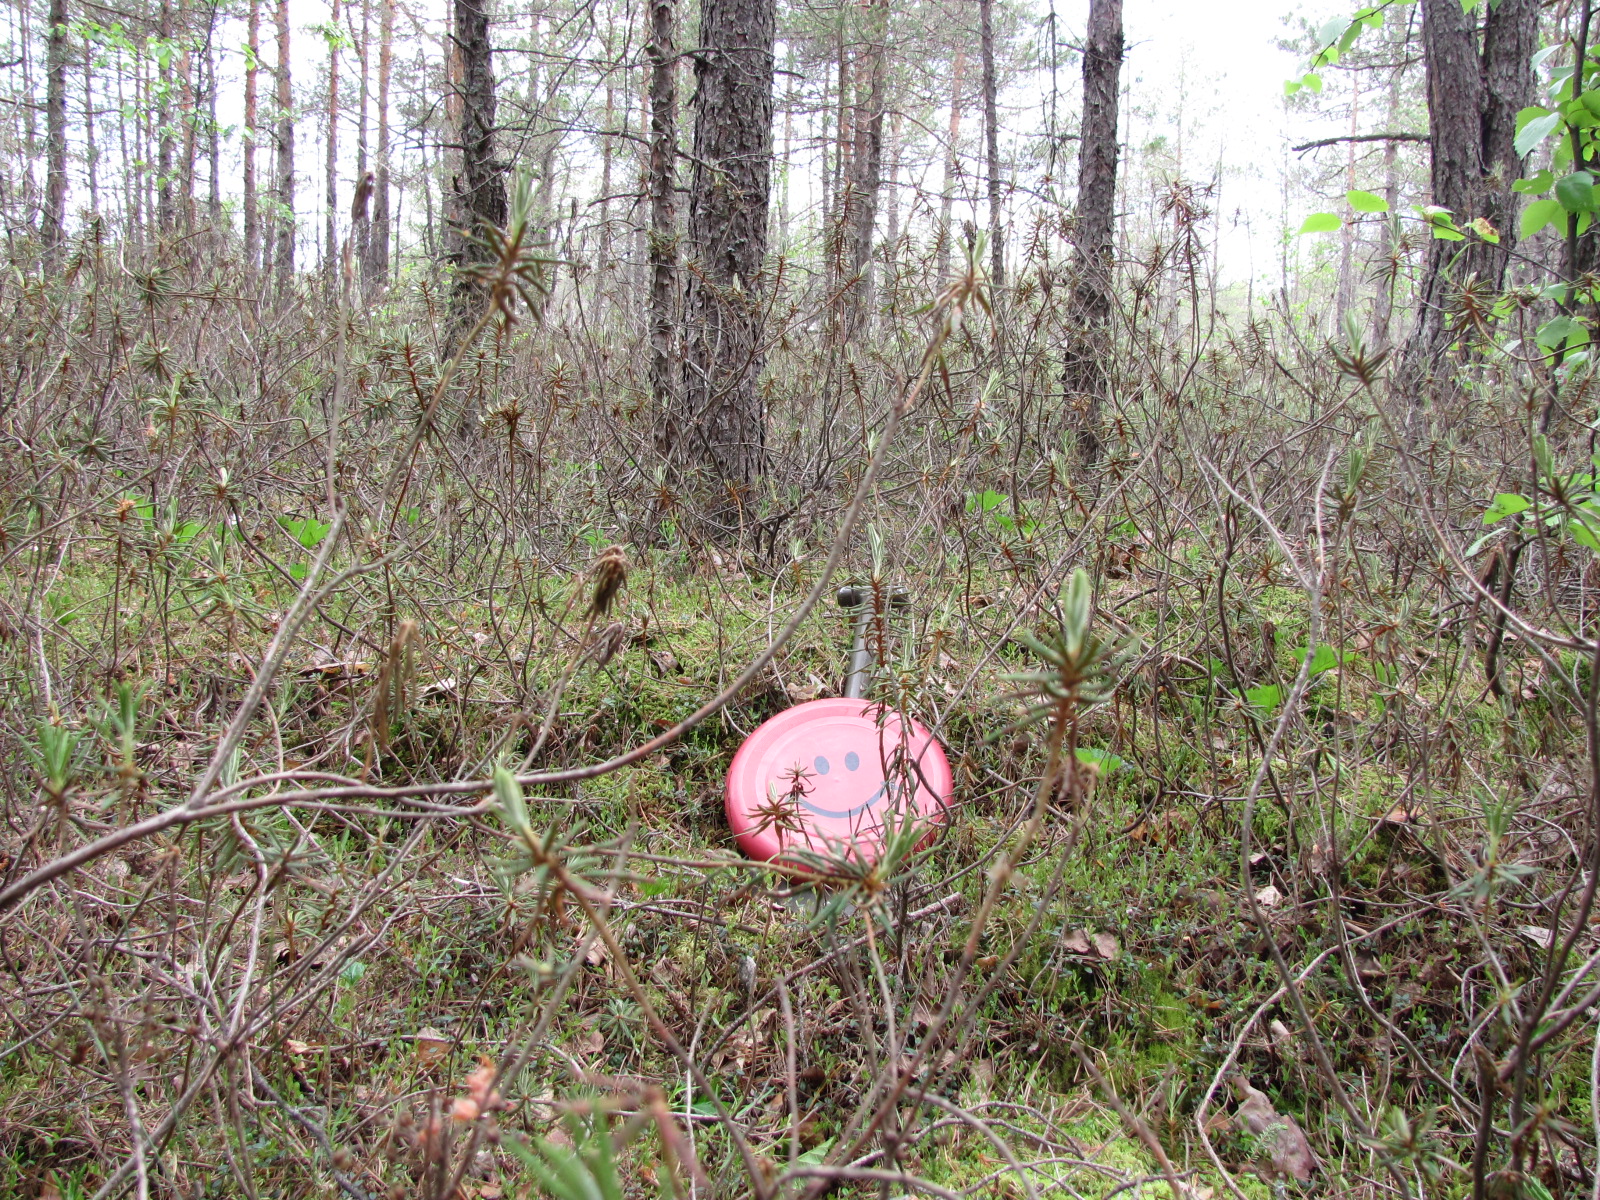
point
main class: Woodland
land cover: Pine dominated coniferous woodland
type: mire and swamp forests
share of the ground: > 75 %
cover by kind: coniferous forest trees 75 %, lichens and mosses 15 %, broadleaved forest trees 5 %, herbaceous plants 5 %
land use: Semi-natural and natural areas not in use
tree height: > 5 m
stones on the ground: < 10 %
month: June
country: LV
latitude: 56.8481
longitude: 23.9368
